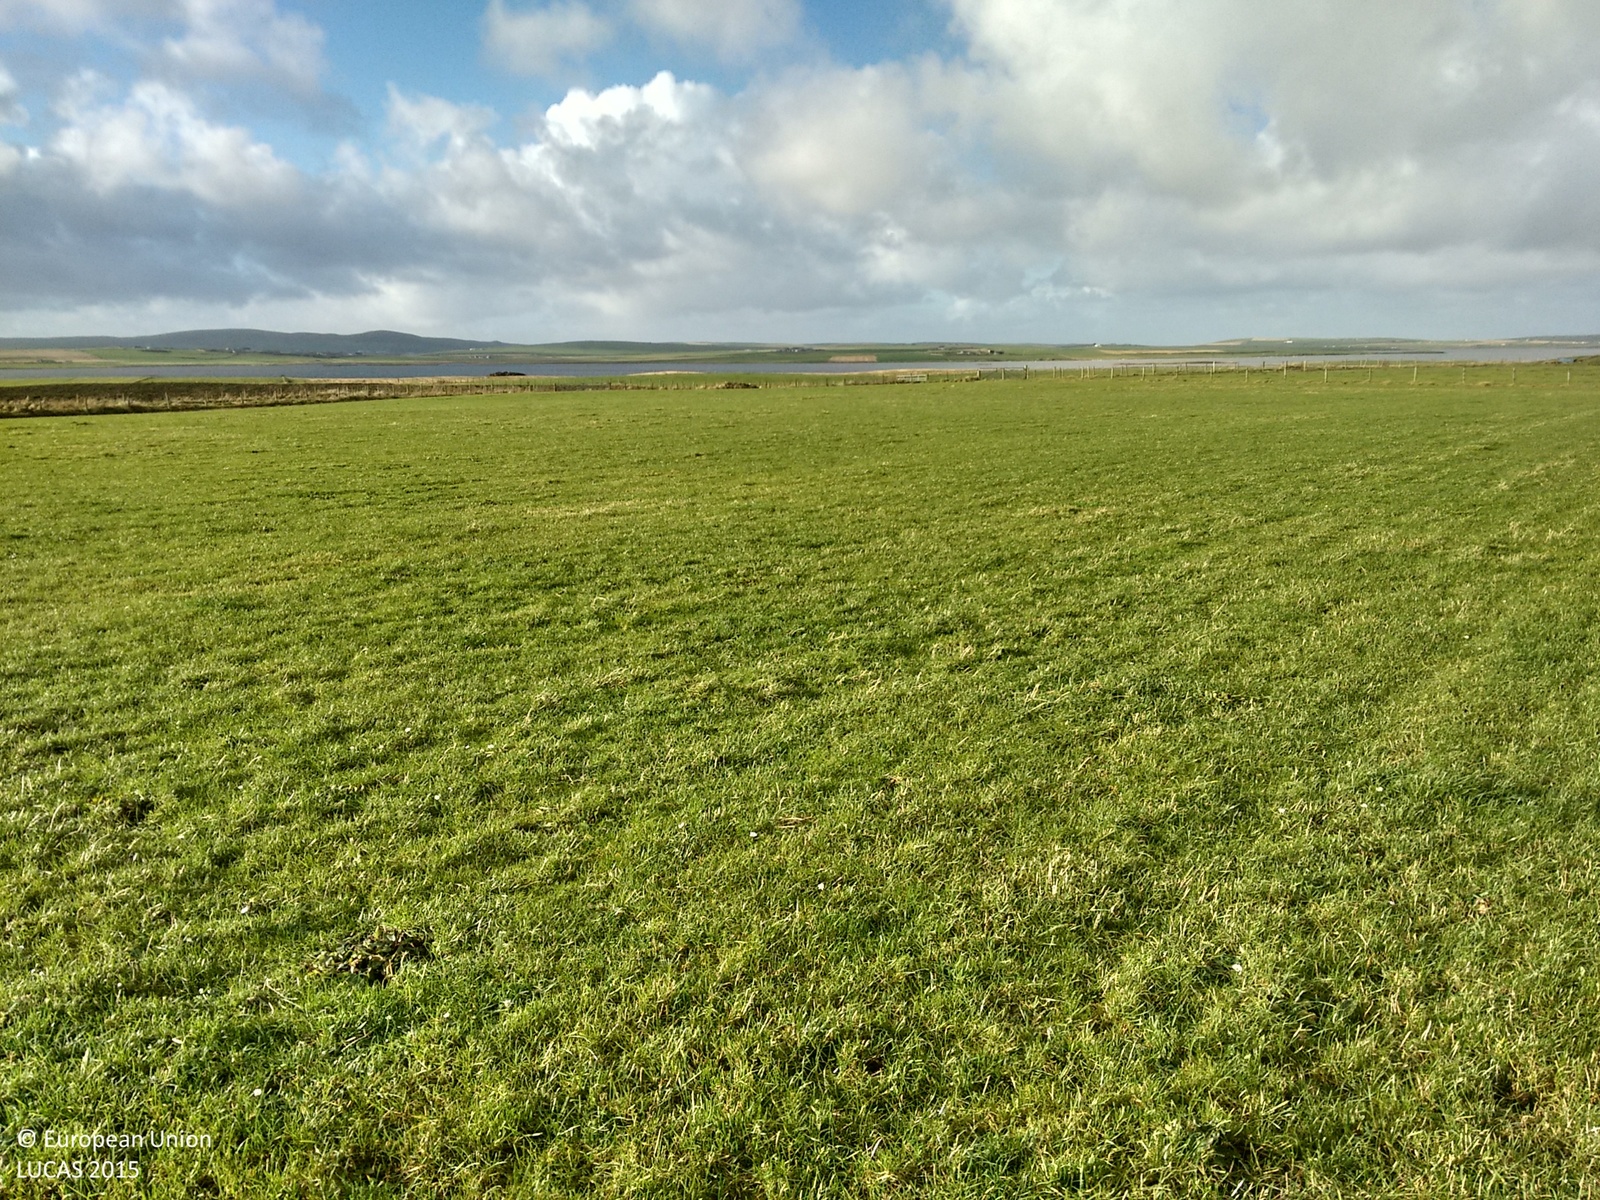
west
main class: Grassland
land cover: Grassland without tree/shrub cover
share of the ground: > 75 %
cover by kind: herbaceous plants 100 %
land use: Agriculture (excluding fallow land and kitchen gardens)
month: November
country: GB
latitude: 59.0256
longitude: -3.2083
